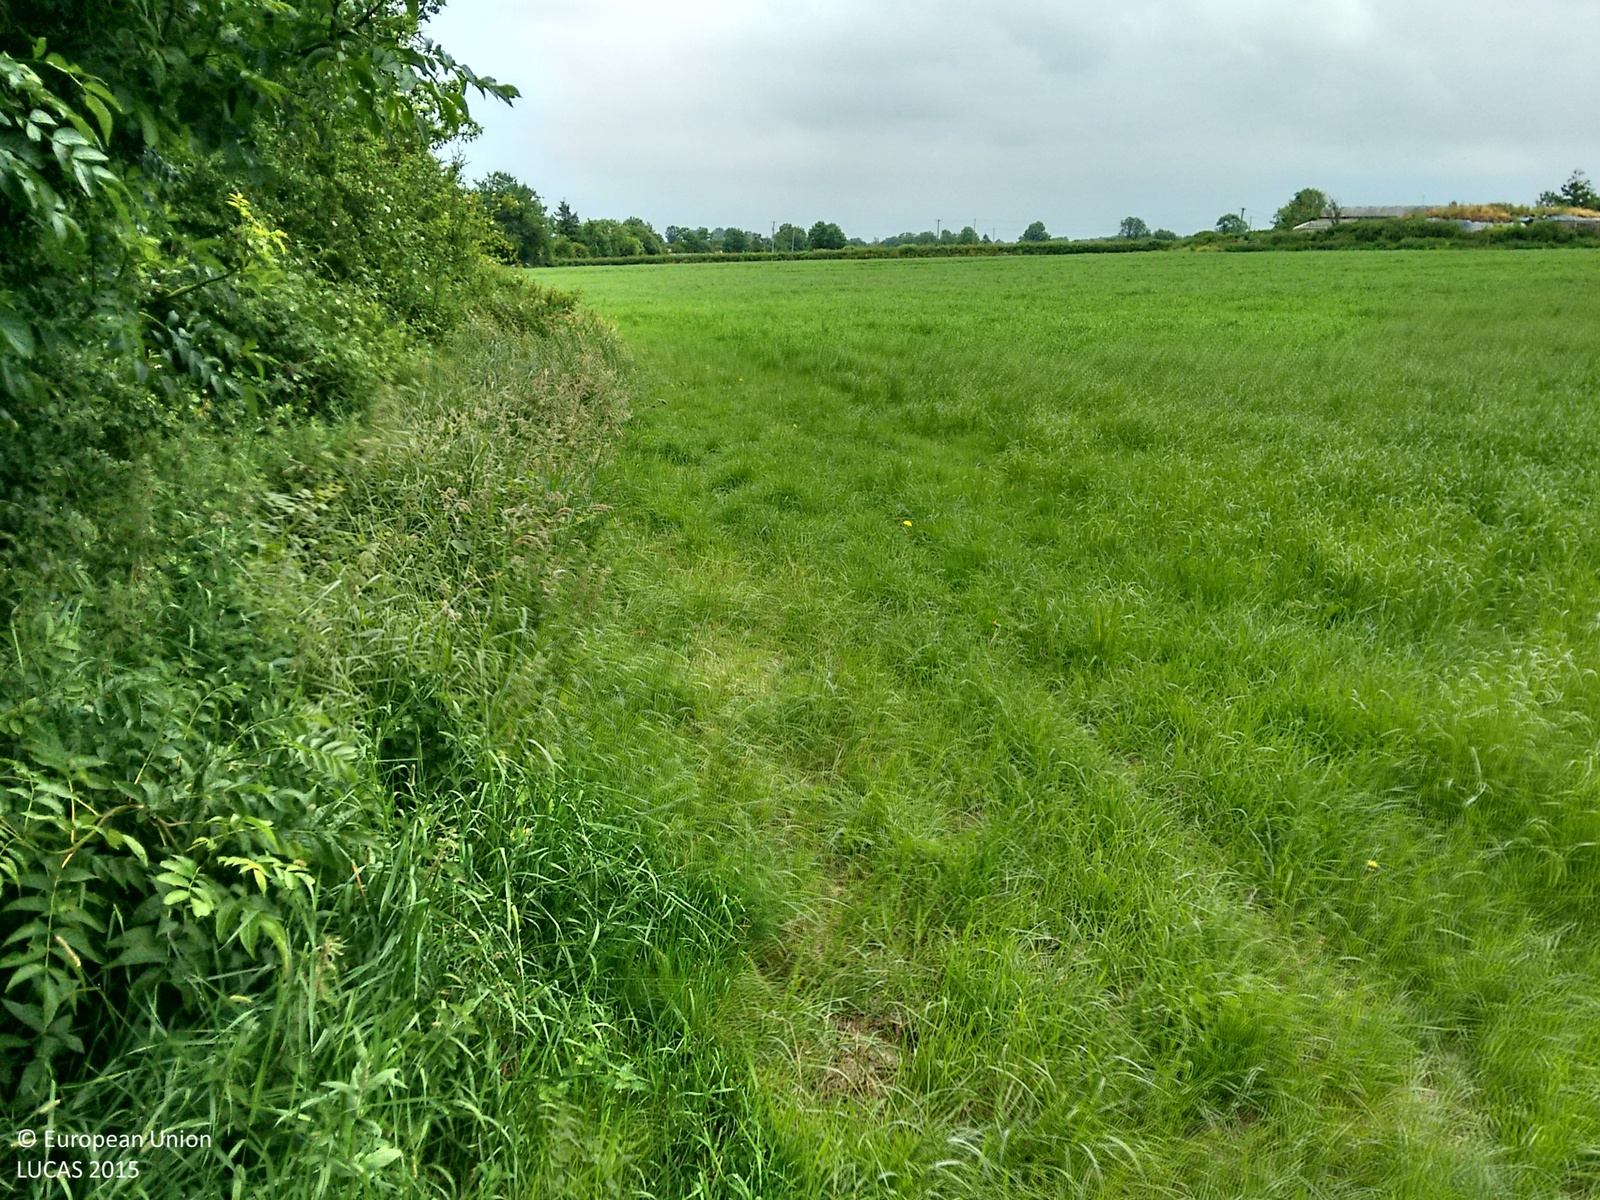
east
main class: Grassland
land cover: Grassland without tree/shrub cover
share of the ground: > 75 %
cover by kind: herbaceous plants 100 %
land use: Agriculture (excluding fallow land and kitchen gardens)
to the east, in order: Grassland without tree/shrub cover; Fences; Managed hedges; Ditches and canals; Managed hedges; Grassland without tree/shrub cover; Managed hedges; Fences; Grassland without tree/shrub cover
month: July
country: IE
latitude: 52.5302
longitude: -7.4179
